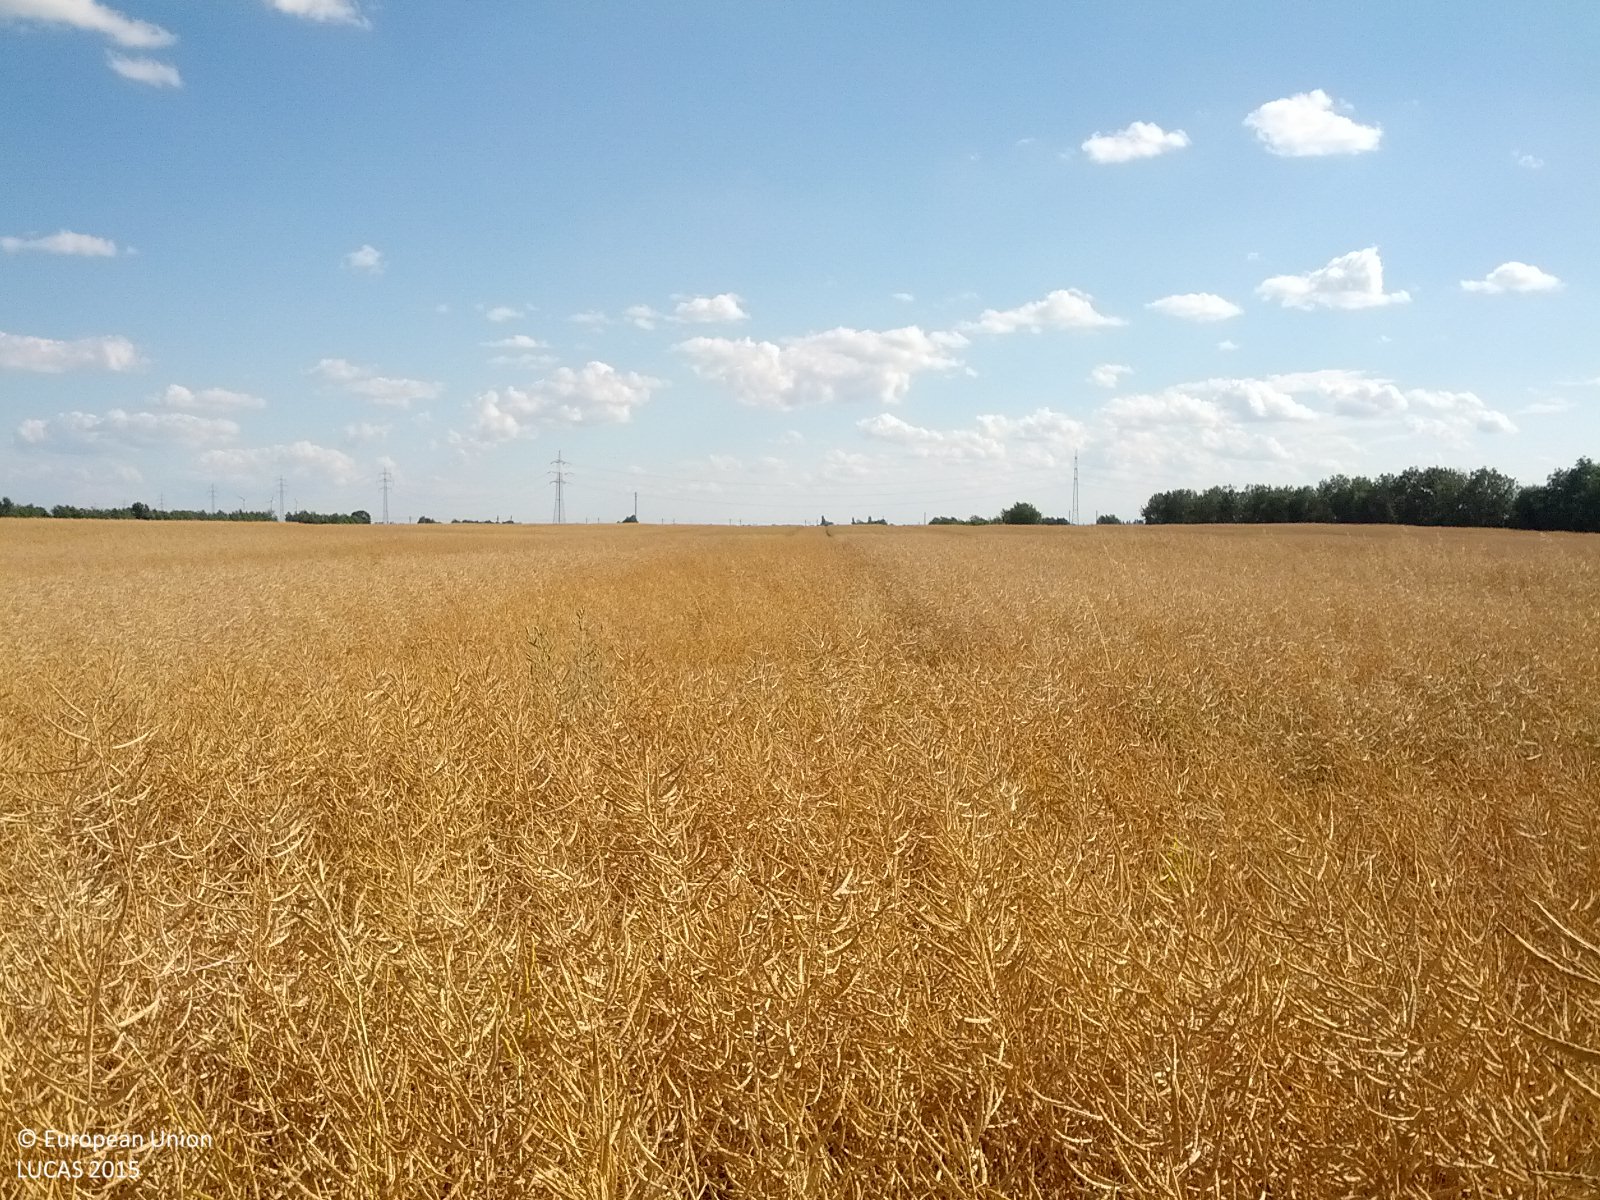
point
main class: Cropland
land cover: Rape and turnip rape
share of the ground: > 75 %
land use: Agriculture (excluding fallow land and kitchen gardens)
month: June
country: AT
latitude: 48.3015
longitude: 16.5171
